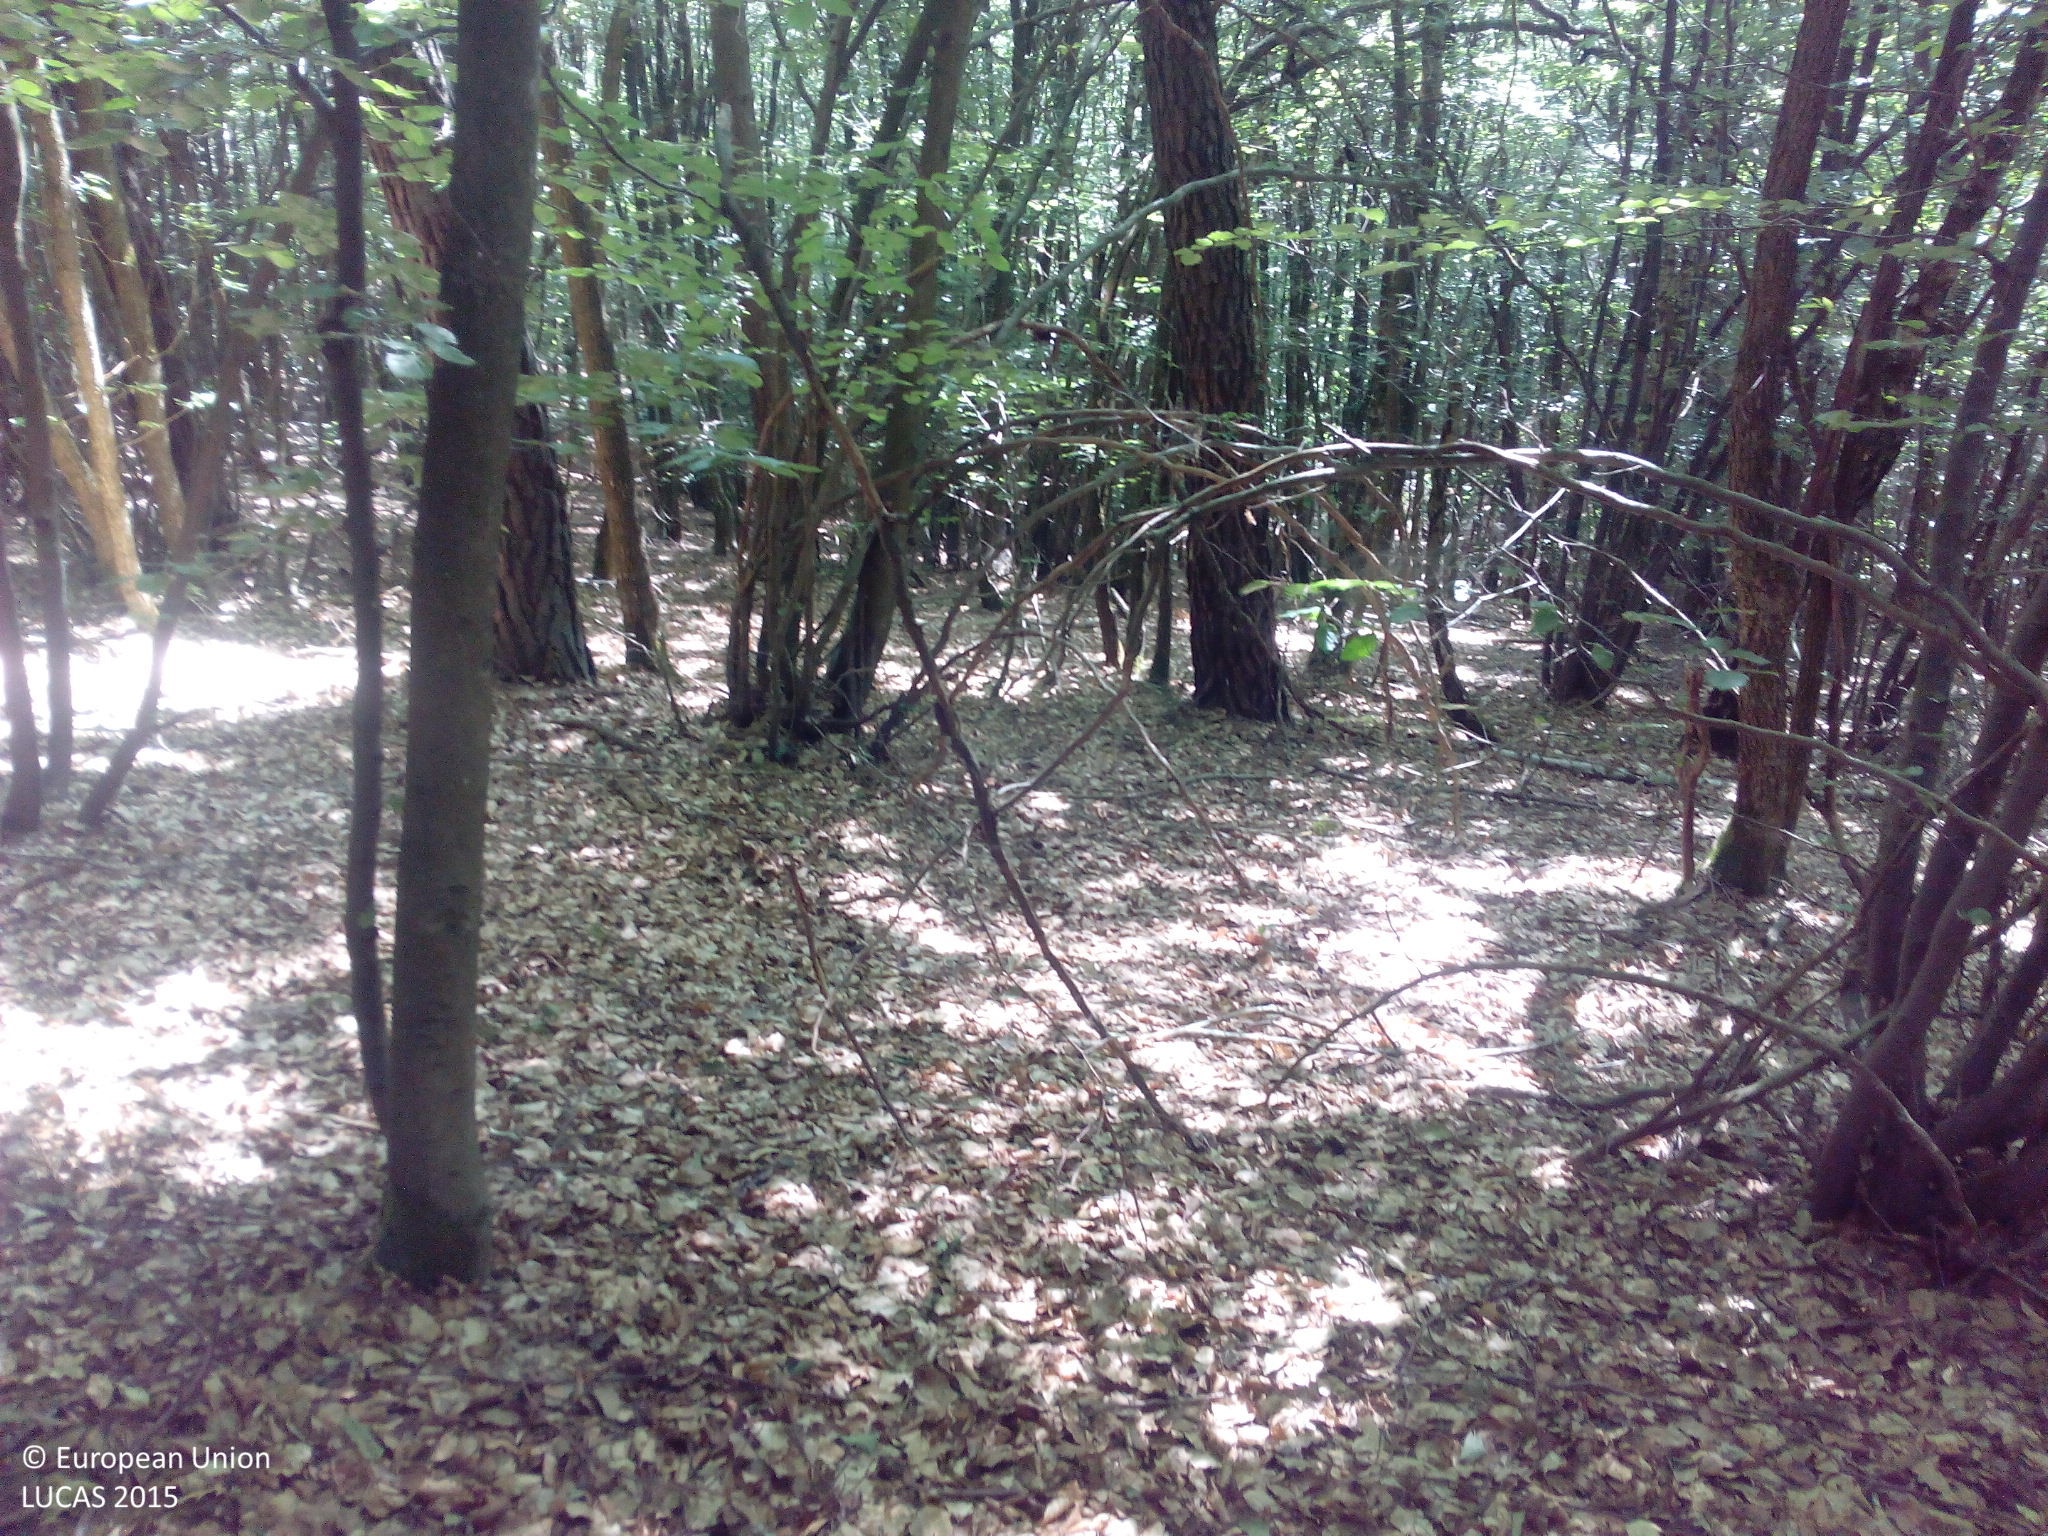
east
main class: Woodland
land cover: Broadleaved woodland
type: mesophytic deciduous forest
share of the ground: > 75 %
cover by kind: broadleaved forest trees 95 %, coniferous forest trees 5 %
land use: Forestry
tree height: > 5 m
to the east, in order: Broadleaved woodland; Tracks; Broadleaved woodland; Grass margins; Ditches and canals; Grass margins; Paved roads, cycling and walking lanes; Grassland without tree/shrub cover; Barley
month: July
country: DE
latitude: 49.6278
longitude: 7.1899
